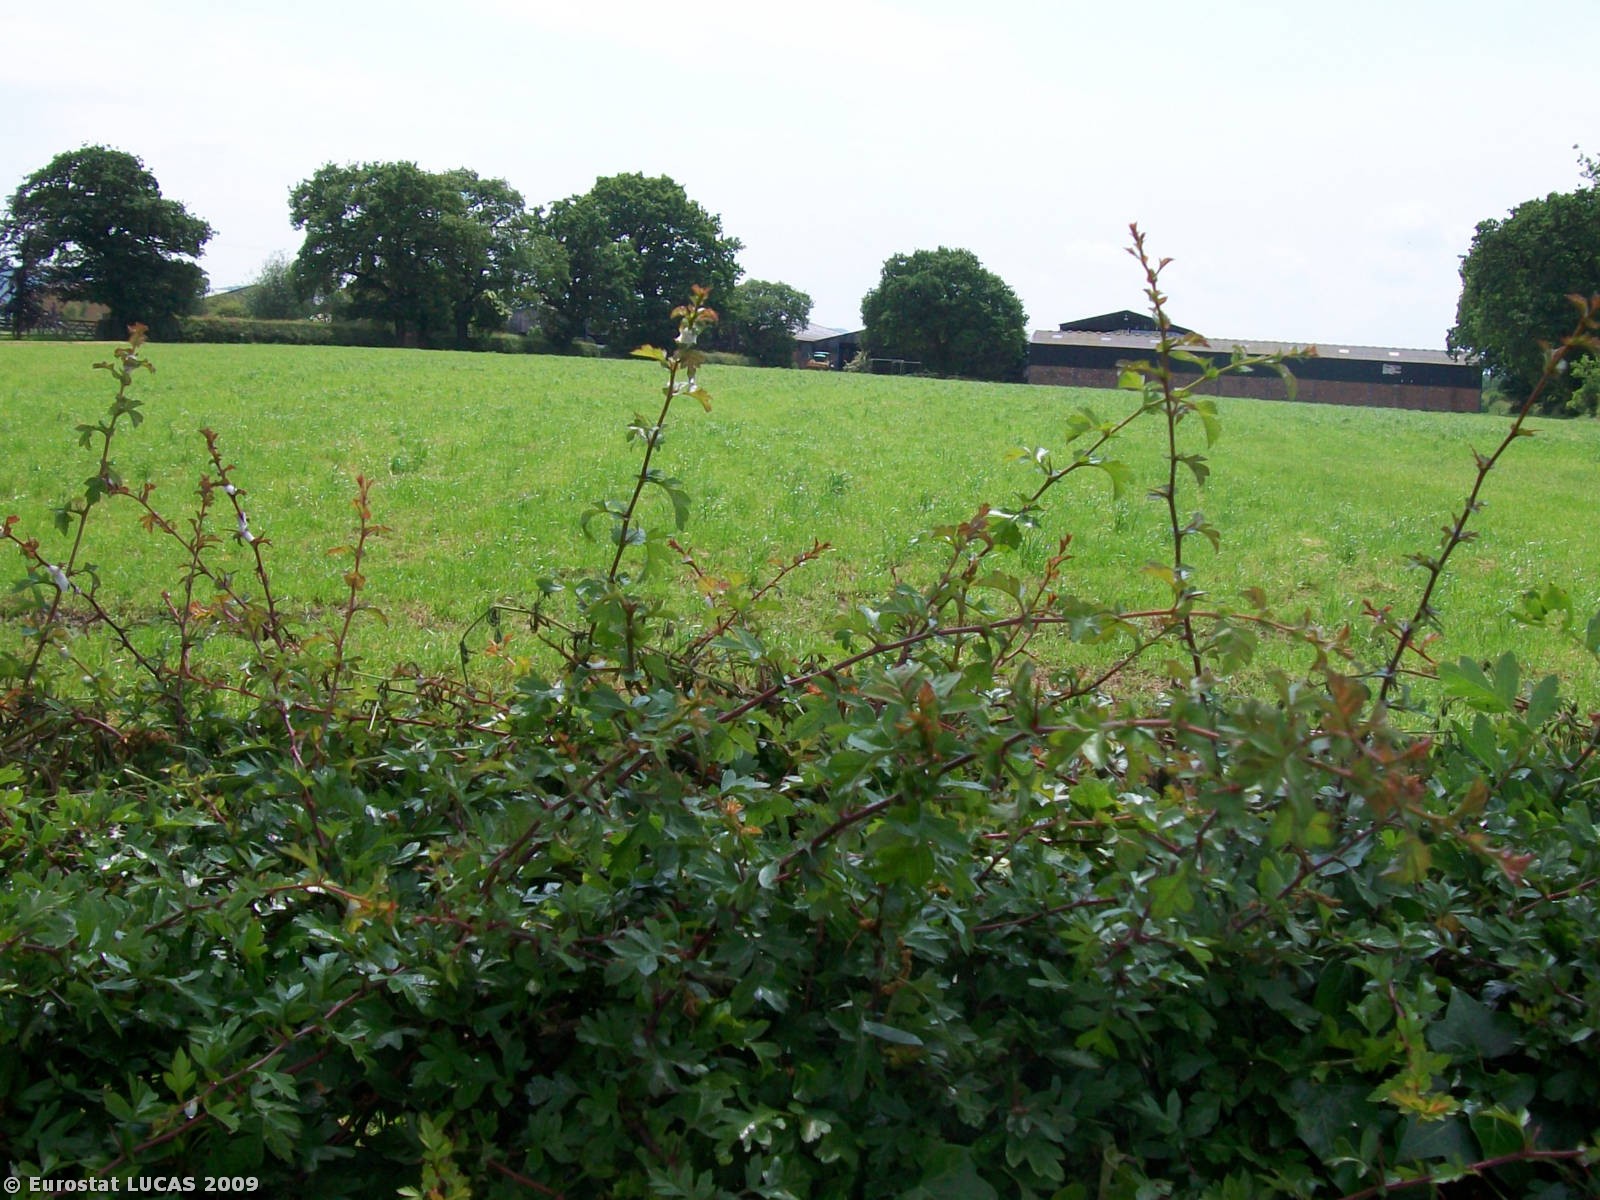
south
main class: Grassland
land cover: Grassland without tree/shrub cover
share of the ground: > 75 %
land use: Agriculture (excluding fallow land and kitchen gardens)
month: June
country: GB
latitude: 53.1659
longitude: -2.7089
